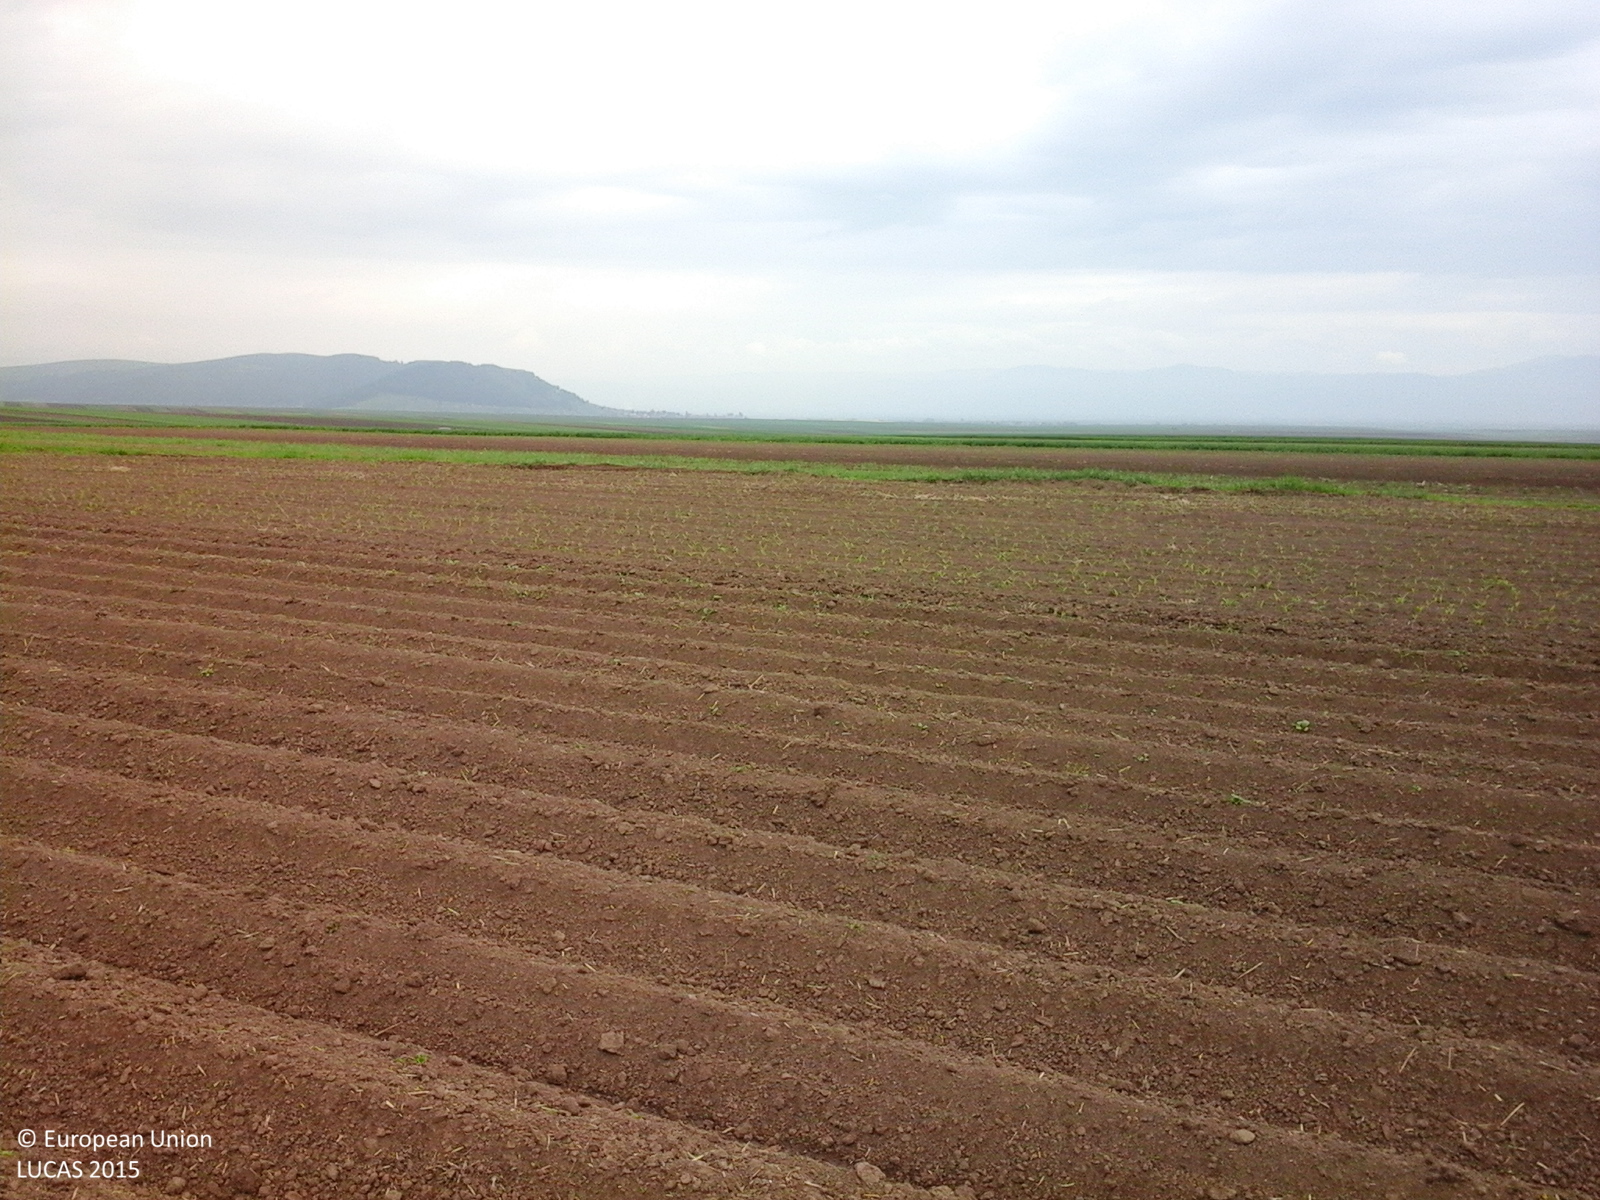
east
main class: Cropland
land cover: Potatoes
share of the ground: < 10 %
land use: Agriculture (excluding fallow land and kitchen gardens)
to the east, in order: Potatoes; Maize; Grass margins; Tracks; Grass margins; Other bare soil; Potatoes; Maize; Common wheat; Potatoes; Common wheat; Potatoes
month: May
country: RO
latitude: 46.0423
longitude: 26.0784
